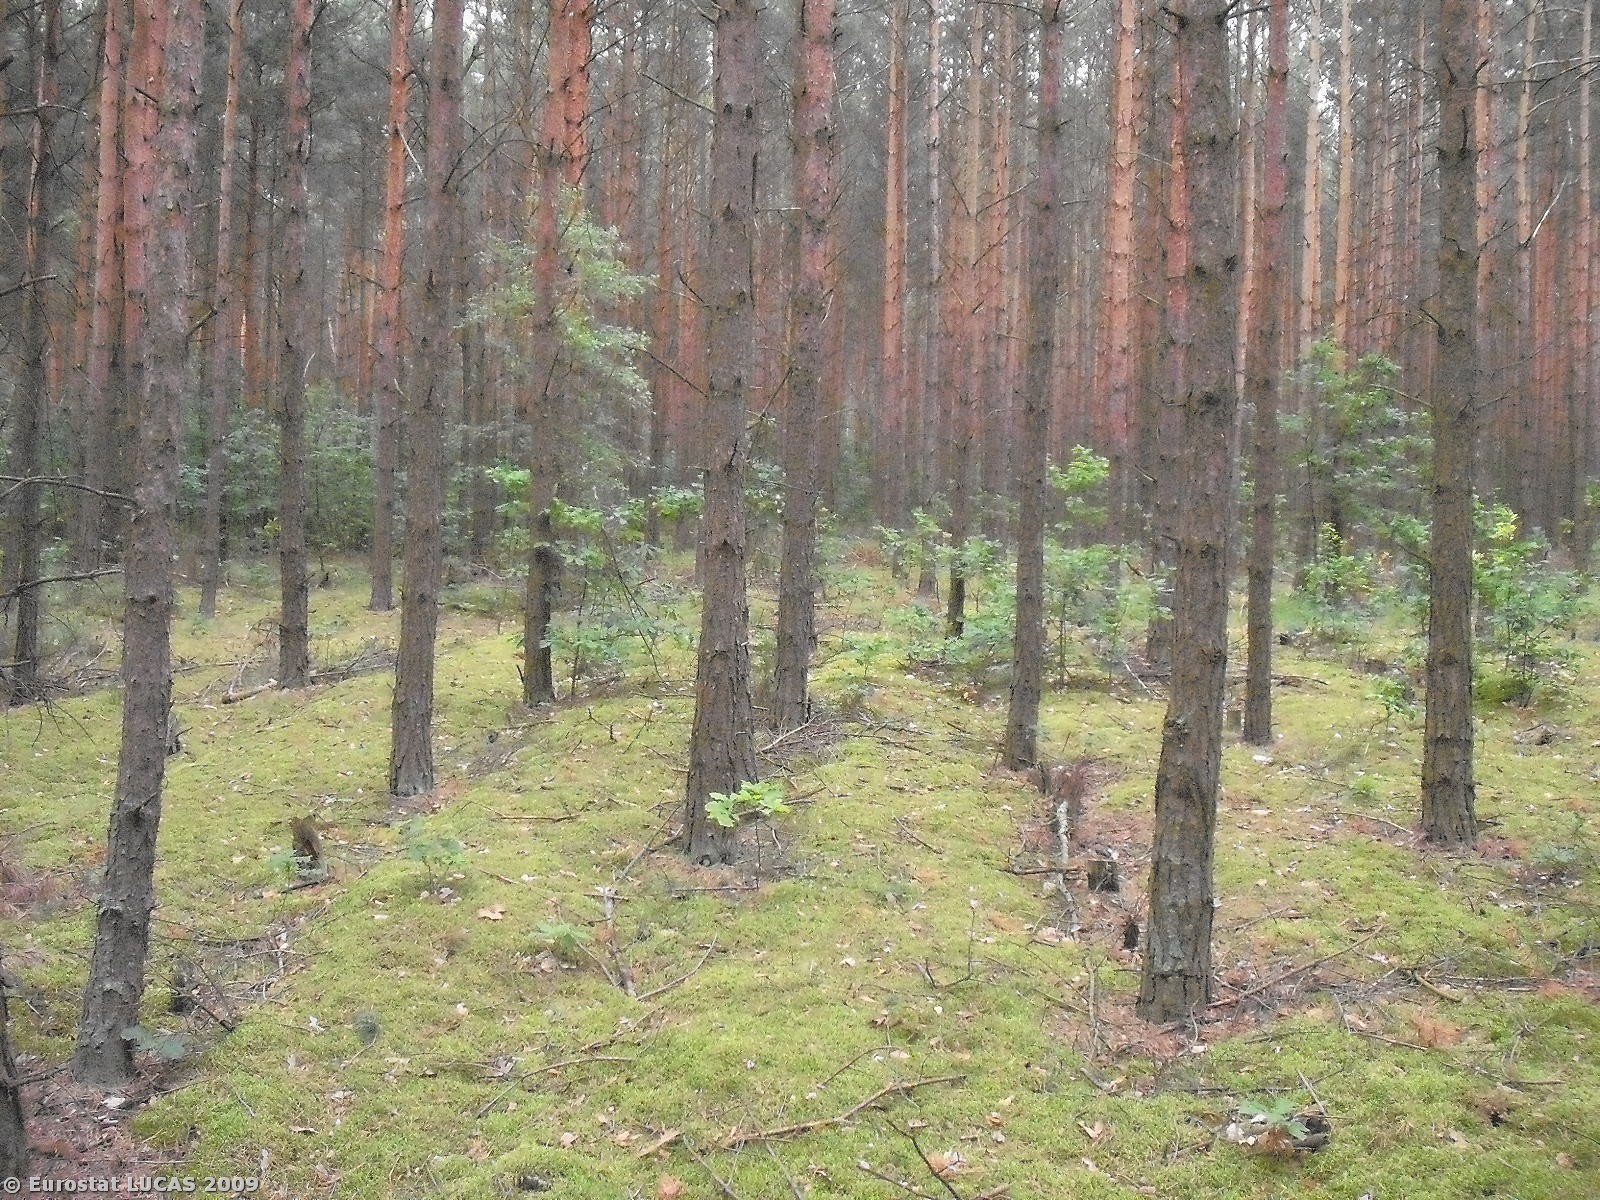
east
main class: Woodland
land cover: Coniferous woodland
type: hemiboreal forest and nemoral coniferous forest and mixed broadleaved-coniferous forest
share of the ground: > 75 %
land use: Forestry
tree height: > 5 m
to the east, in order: Coniferous woodland; Tracks; Coniferous woodland; Tracks; Coniferous woodland; Tracks; Coniferous woodland; Tracks; Coniferous woodland
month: June
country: PL
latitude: 51.4111
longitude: 20.6071
